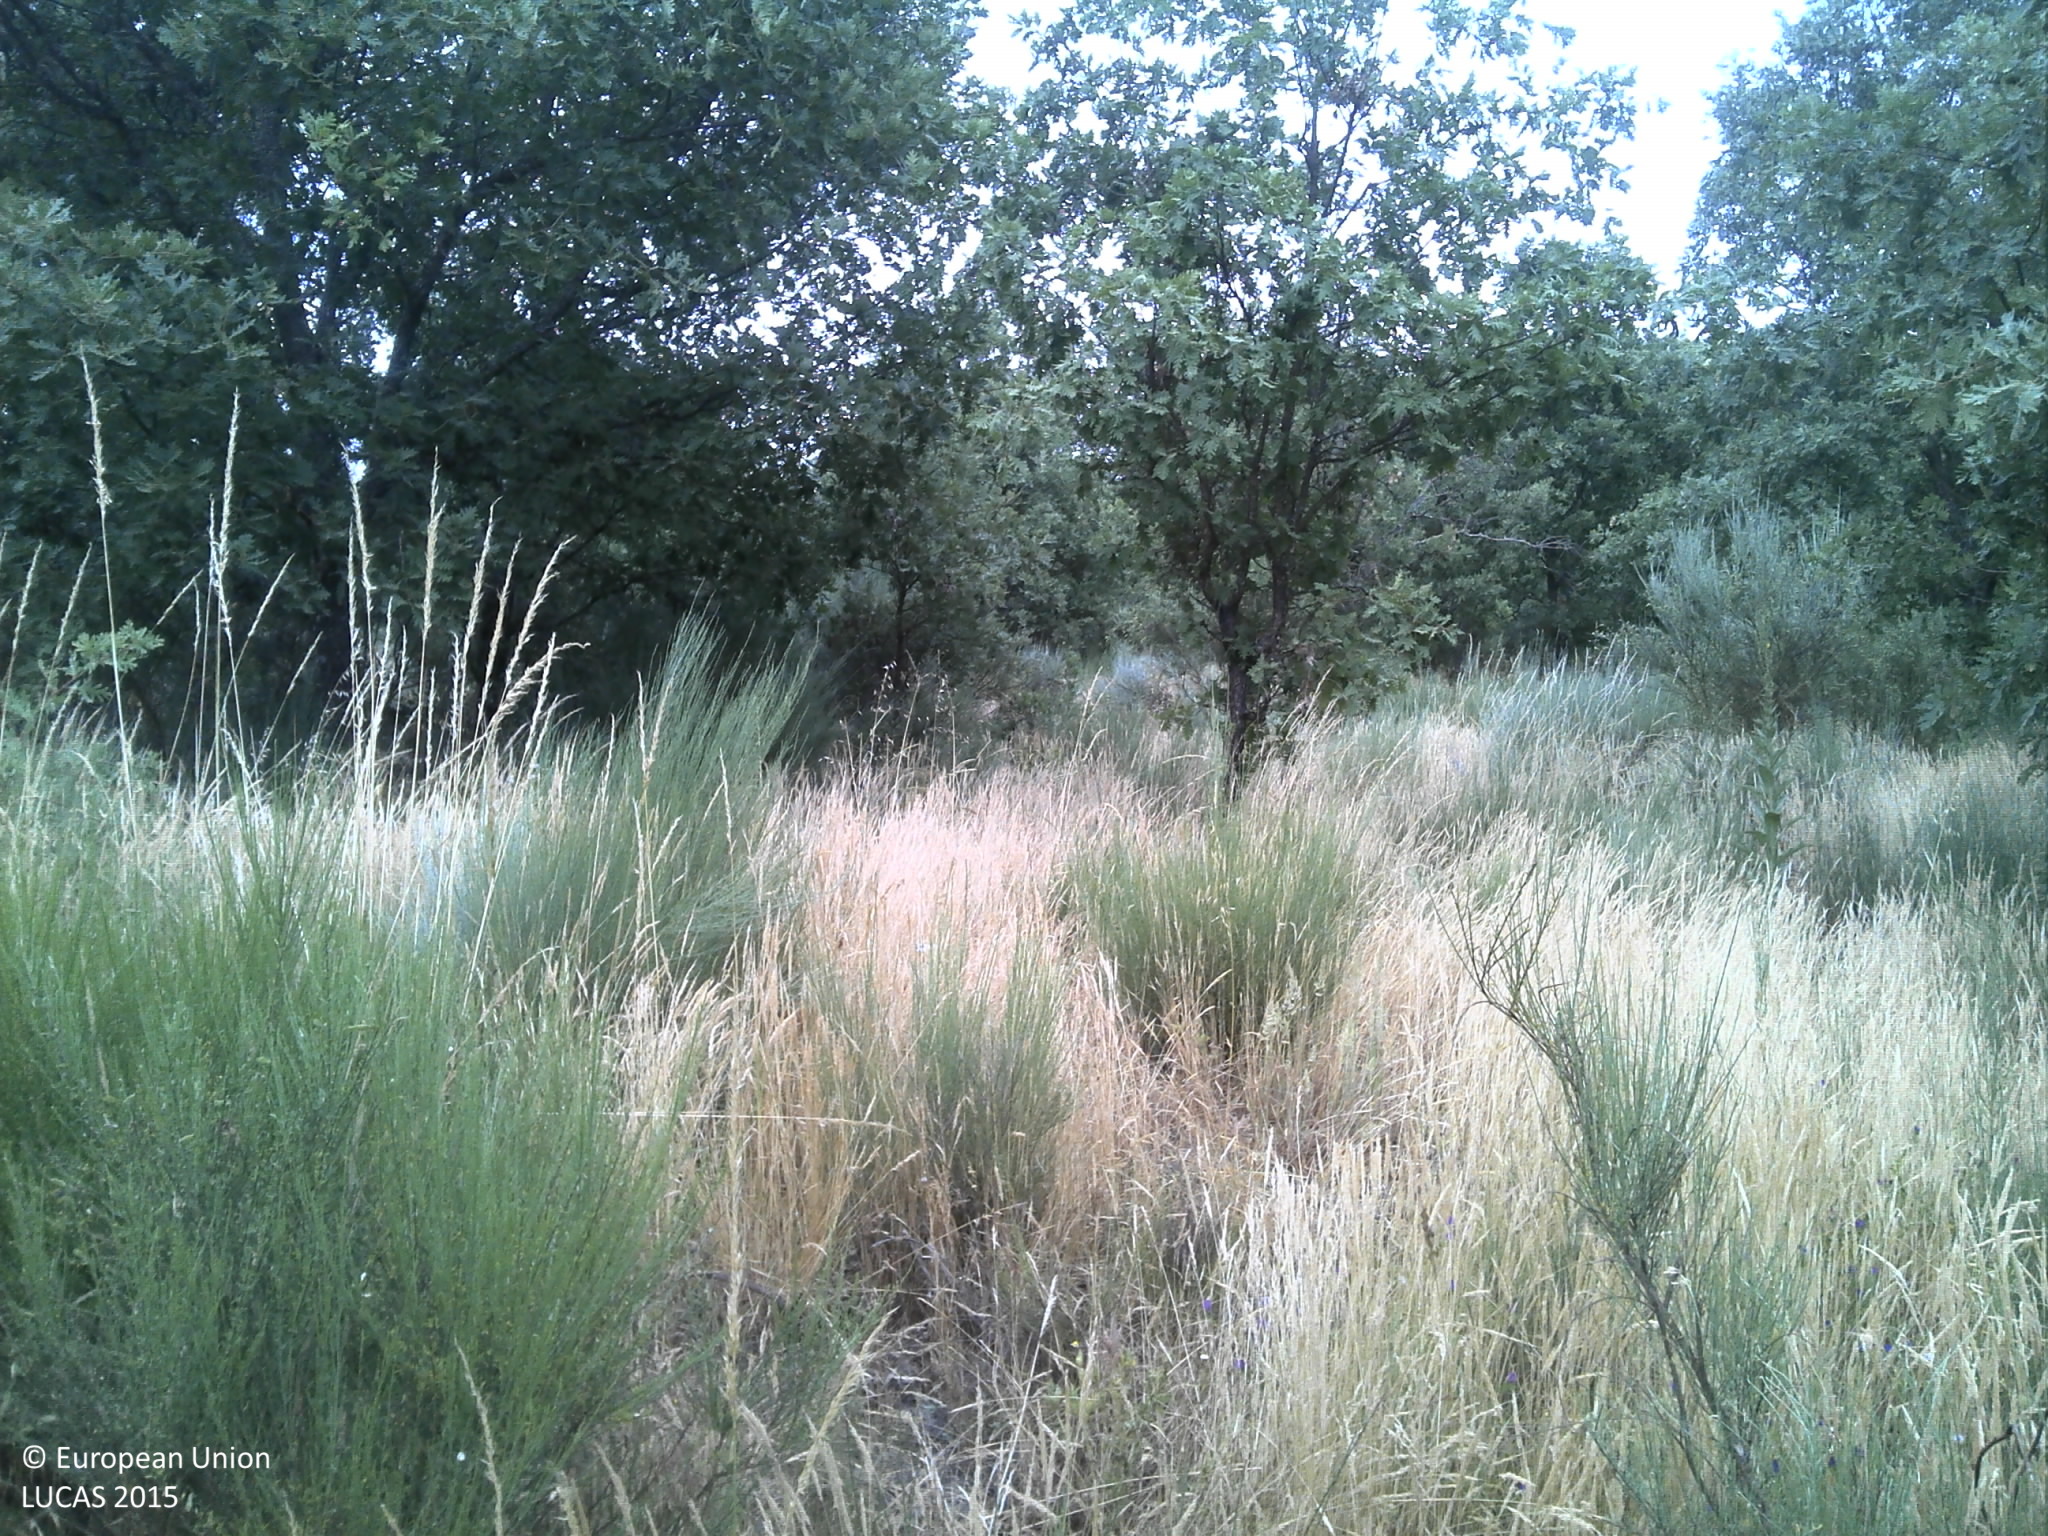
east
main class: Woodland
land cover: Broadleaved woodland
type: acidophilous oak and oak-birch forest
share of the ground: 25 - 50 %
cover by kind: broadleaved forest trees 50 %, shrubs 30 %, unconsolidated bare surface 15 %
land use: Forestry
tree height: > 5 m
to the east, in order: Broadleaved woodland; Rivers and streams; Broadleaved woodland; Spontaneously vegetated surfaces; Dry stone walls; Single bushes/trees; Spontaneously vegetated surfaces; Dry stone walls; Spontaneously vegetated surfaces; Tracks; Broadleaved woodland; Tracks; Fences; Shrubland without tree cover
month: June
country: PT
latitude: 40.2847
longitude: -7.4073
